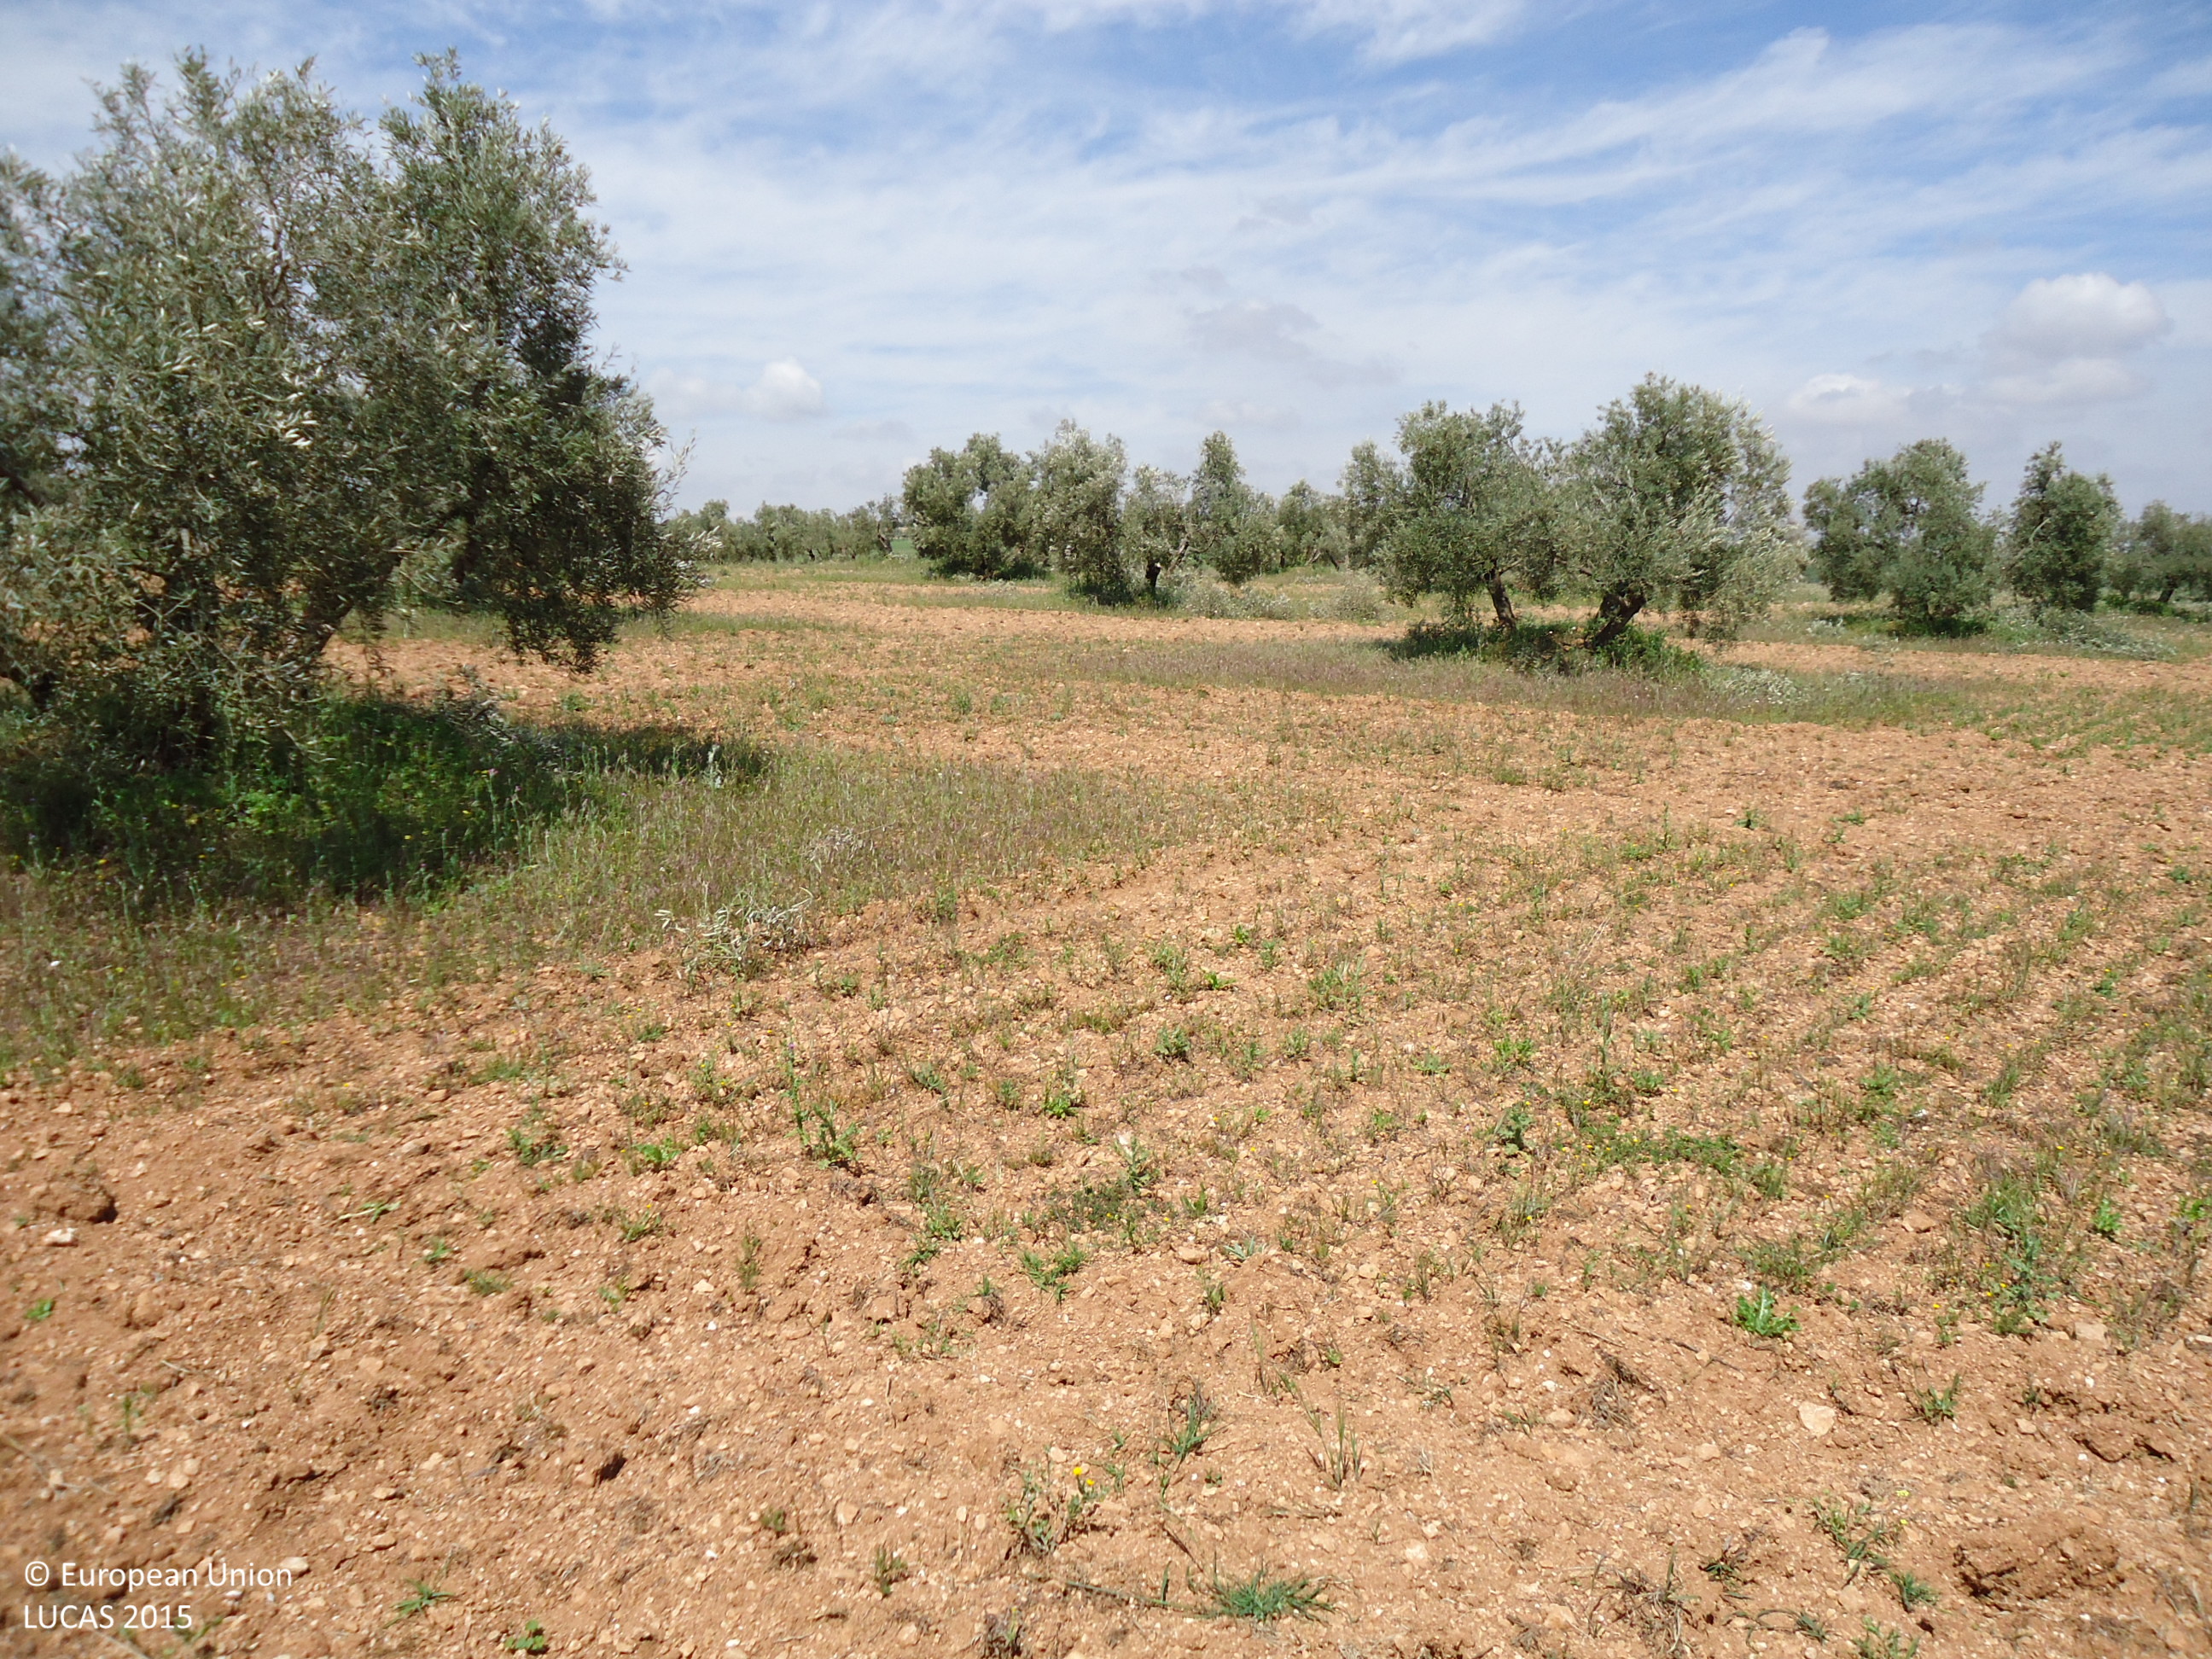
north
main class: Cropland
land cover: Olive groves
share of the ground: 10 - 25 %
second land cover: Spontaneously vegetated surfaces
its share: > 75 %
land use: Agriculture (excluding fallow land and kitchen gardens)
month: April
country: ES
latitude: 37.0770
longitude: -4.8149
